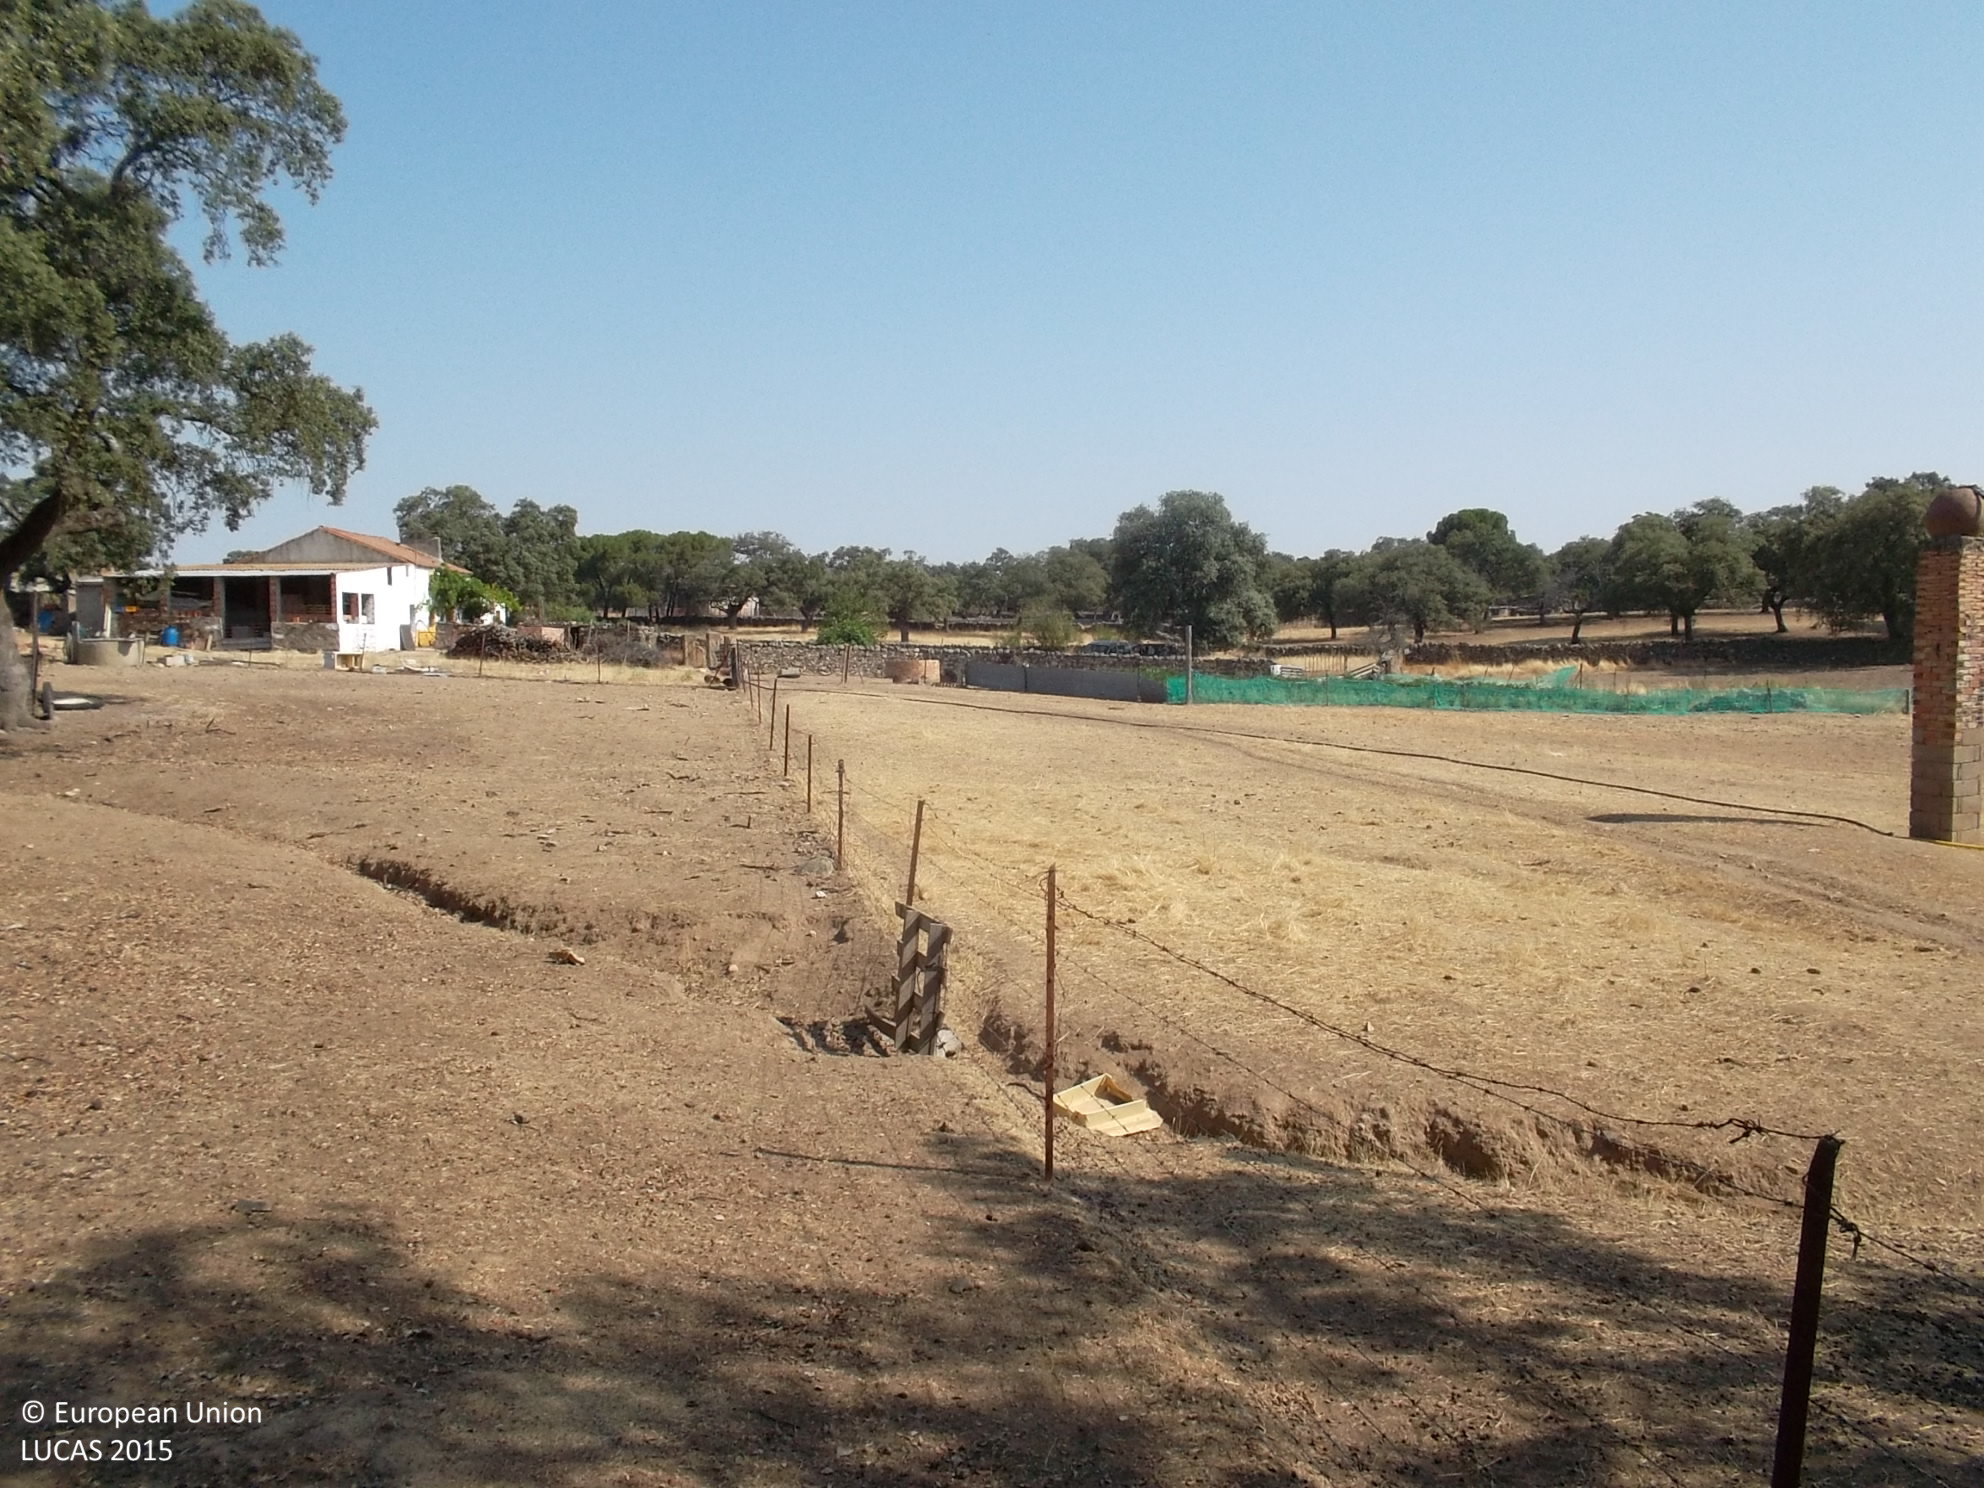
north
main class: Woodland
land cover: Broadleaved woodland
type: broadleaved evergreen forest
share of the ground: 25 - 50 %
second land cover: Grassland without tree/shrub cover
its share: 10 - 25 %
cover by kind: unconsolidated bare surface 45 %, broadleaved forest trees 40 %, herbaceous plants 15 %
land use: Forestry
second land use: Agriculture (excluding fallow land and kitchen gardens)
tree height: > 5 m
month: July
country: ES
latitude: 38.2242
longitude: -4.6509
